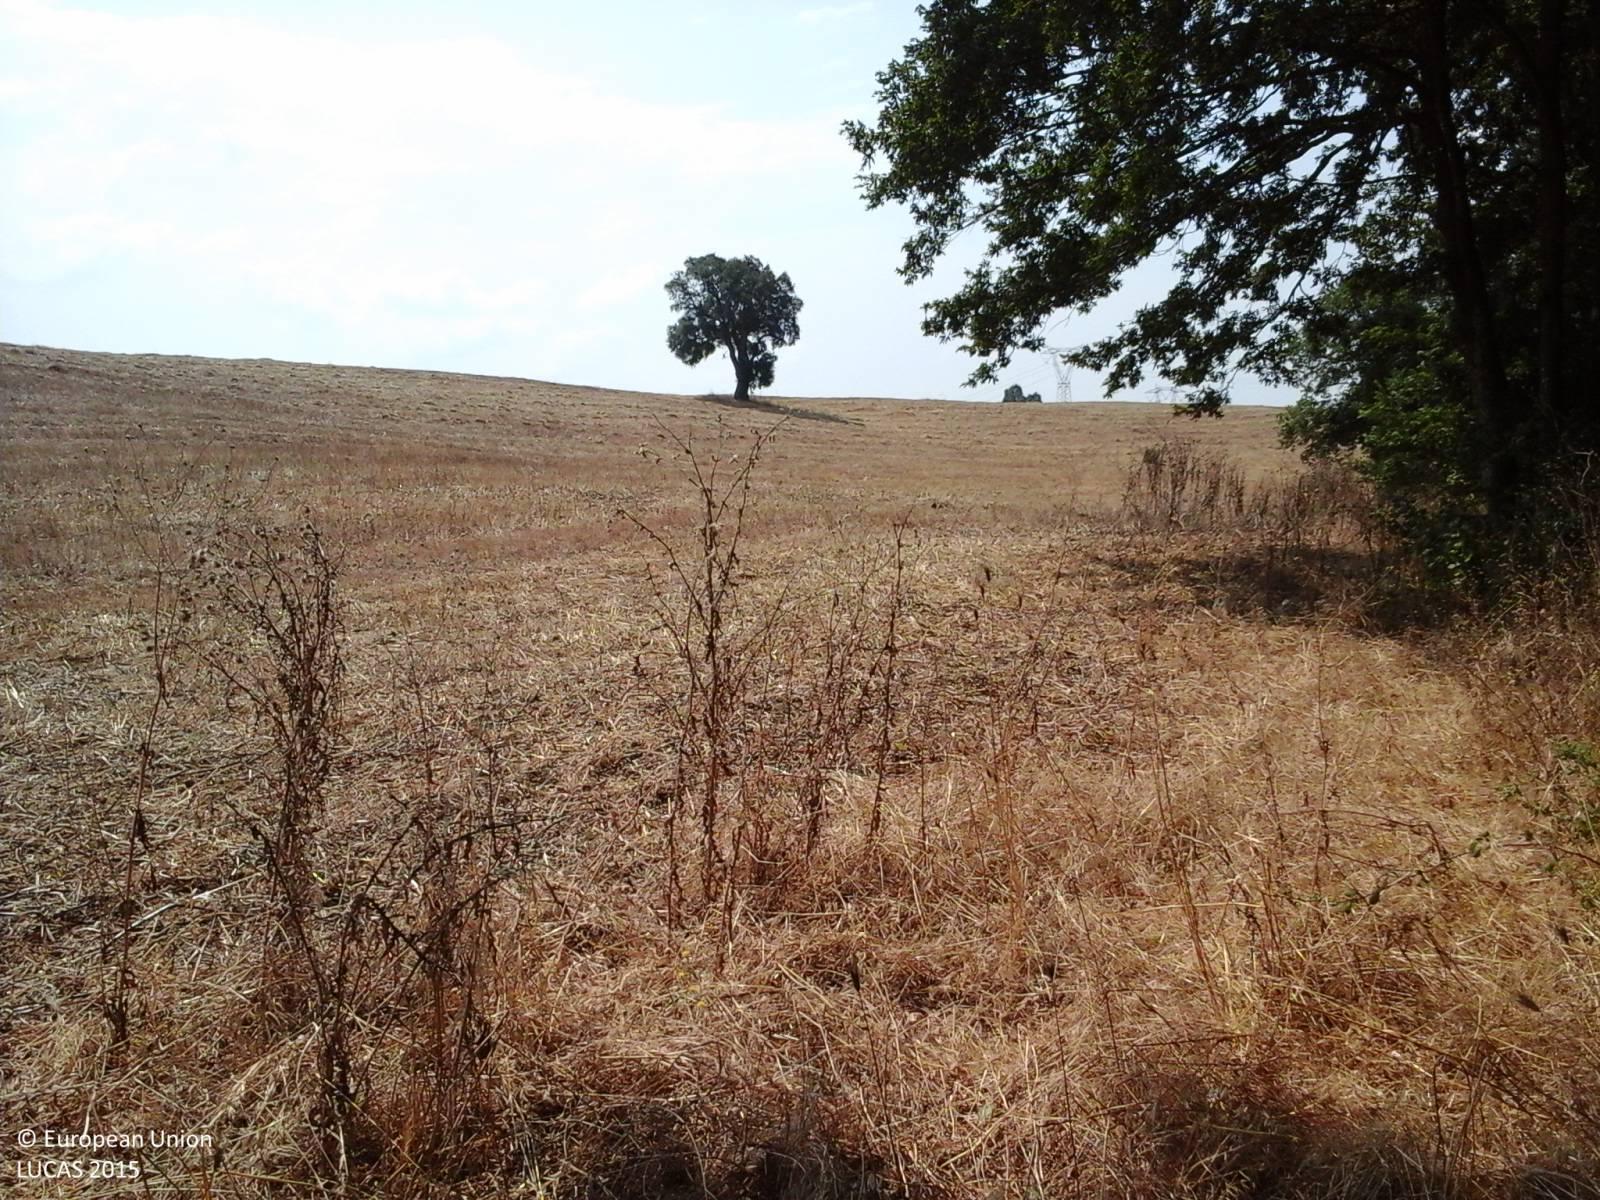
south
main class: Woodland
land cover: Broadleaved woodland
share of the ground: > 75 %
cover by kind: broadleaved forest trees 100 %
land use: Semi-natural and natural areas not in use
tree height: > 5 m
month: July
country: IT
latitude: 41.9976
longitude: 12.2011
